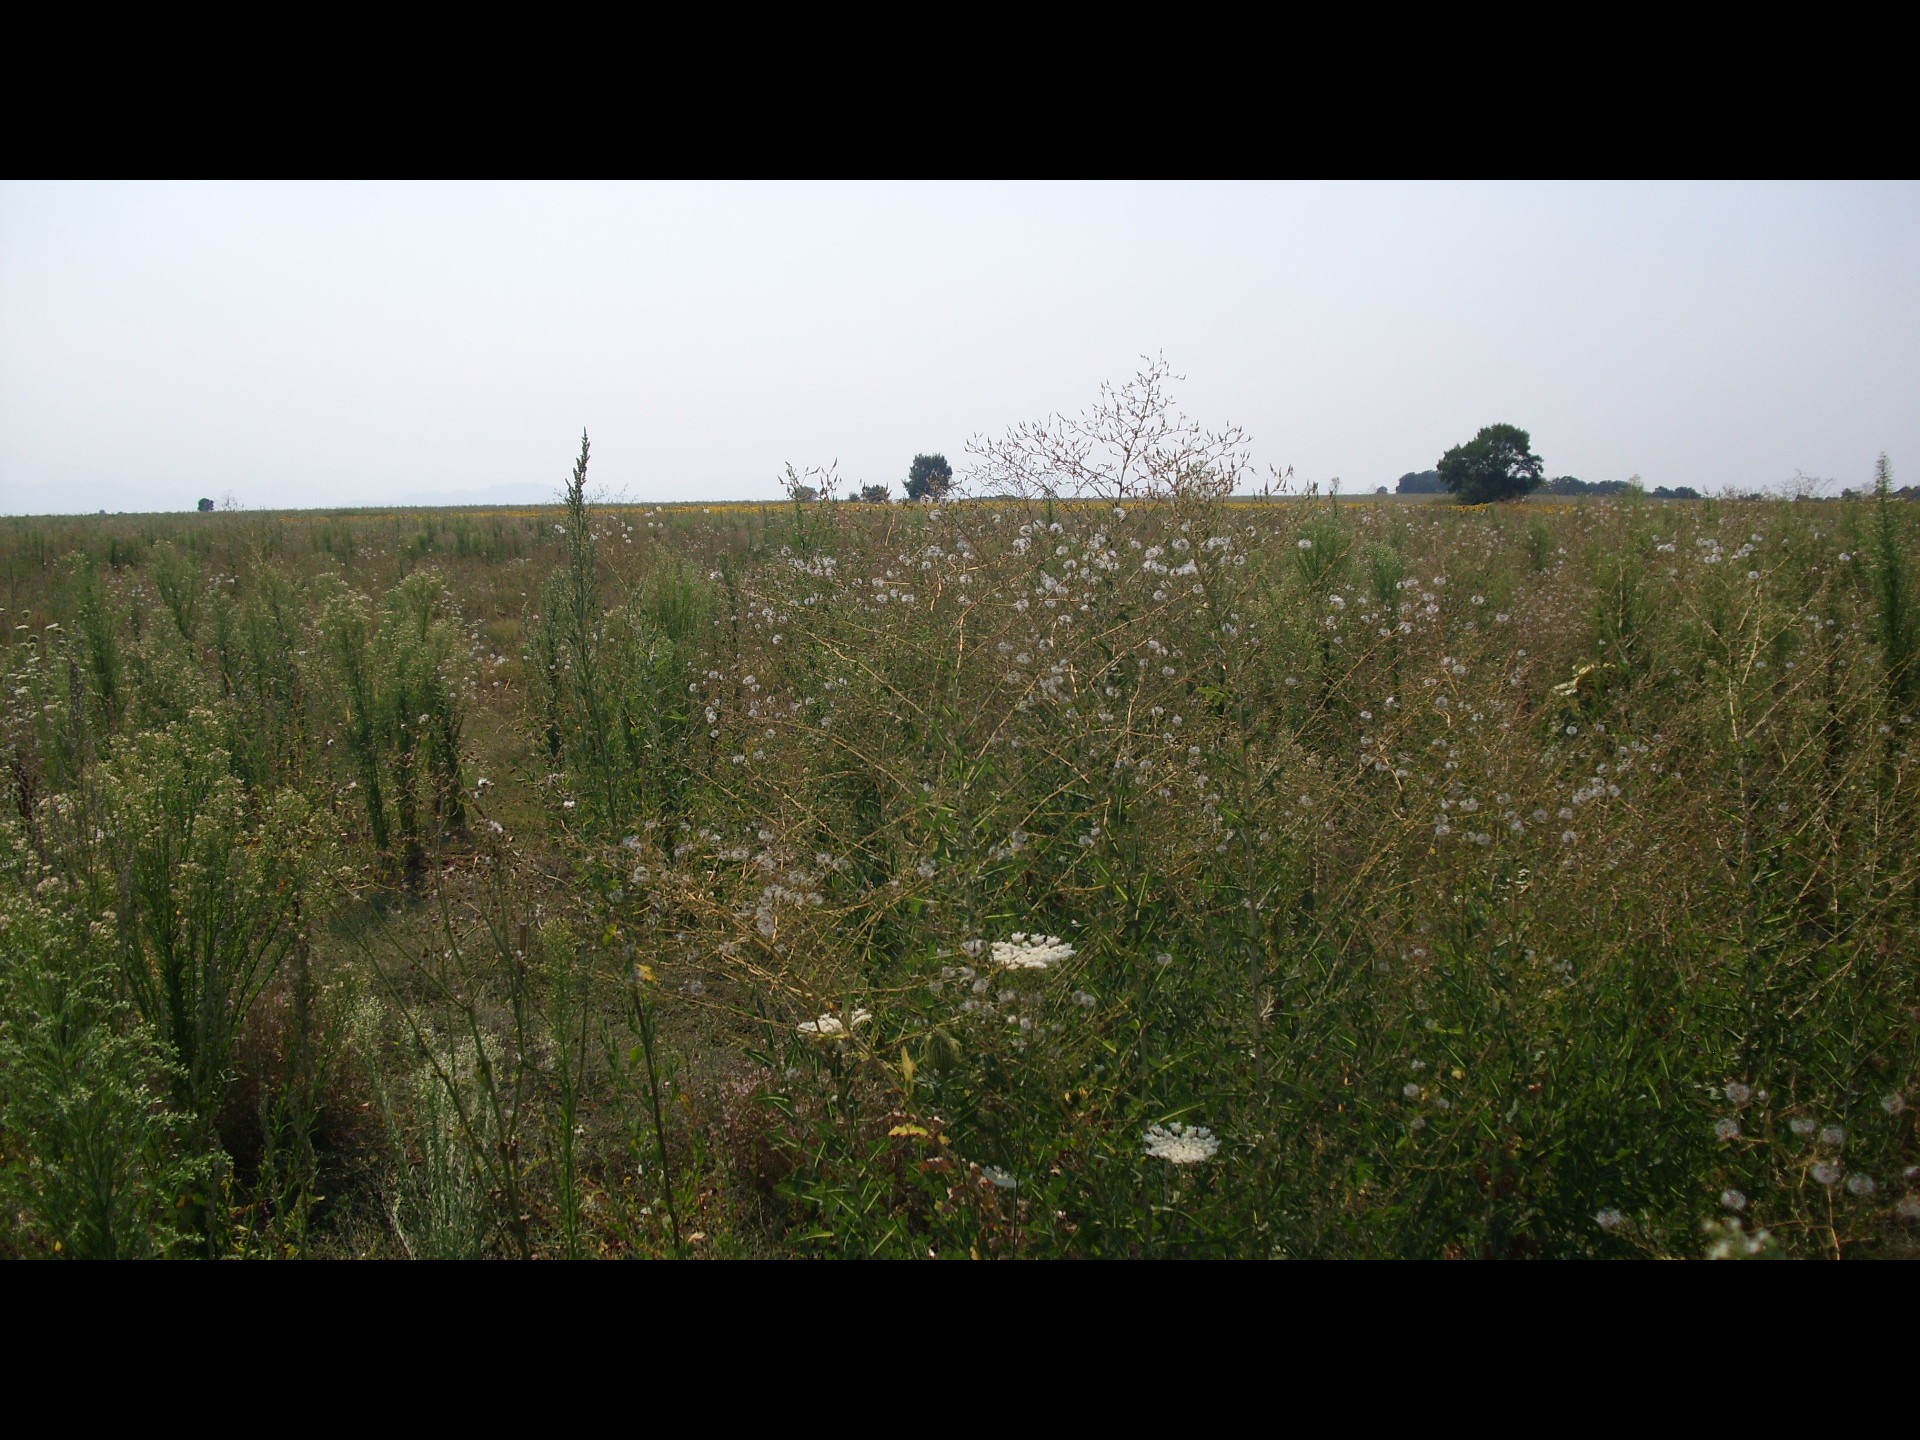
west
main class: Grassland
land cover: Spontaneously vegetated surfaces
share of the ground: > 75 %
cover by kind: herbaceous plants 100 %
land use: Fallow land
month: July
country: BG
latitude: 43.6269
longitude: 23.0899
